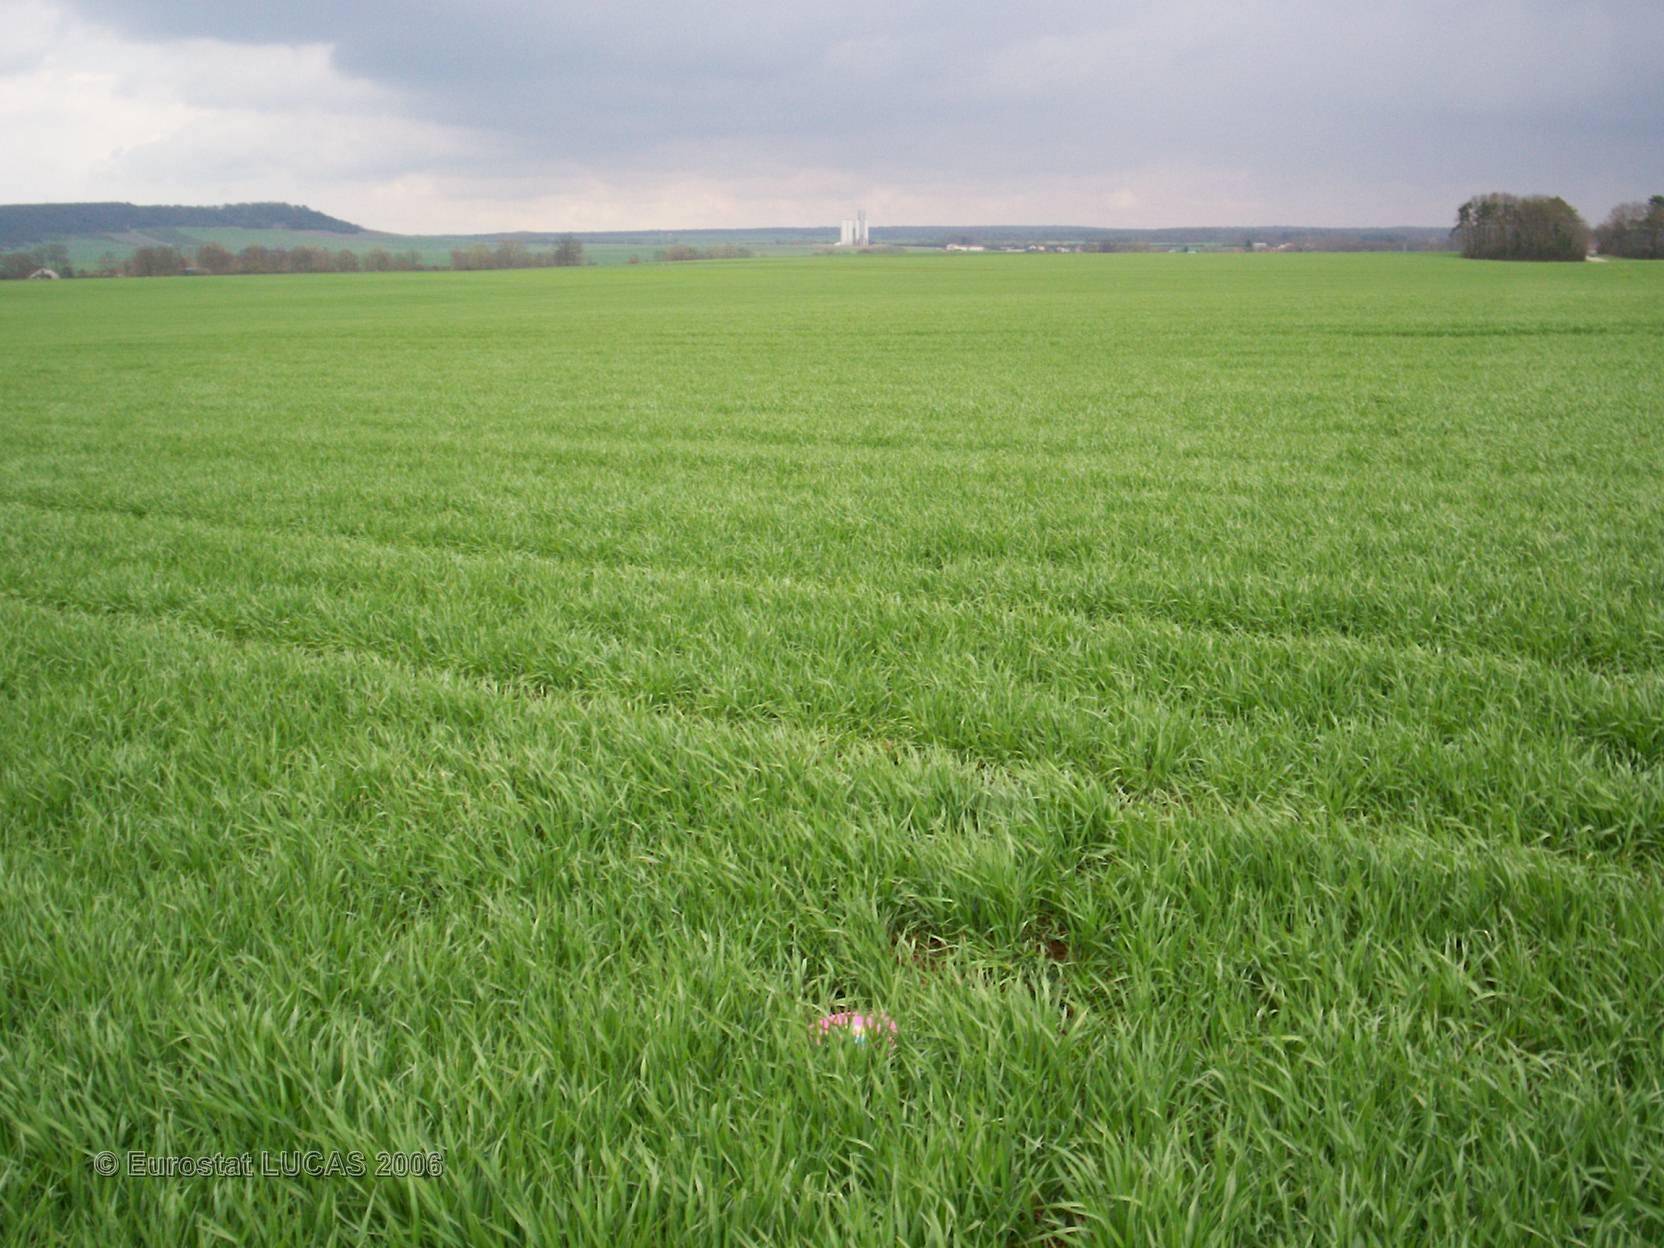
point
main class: Cropland
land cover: Barley
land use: Agriculture (excluding fallow land and kitchen gardens)
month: April
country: FR
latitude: 47.9318
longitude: 4.6580
